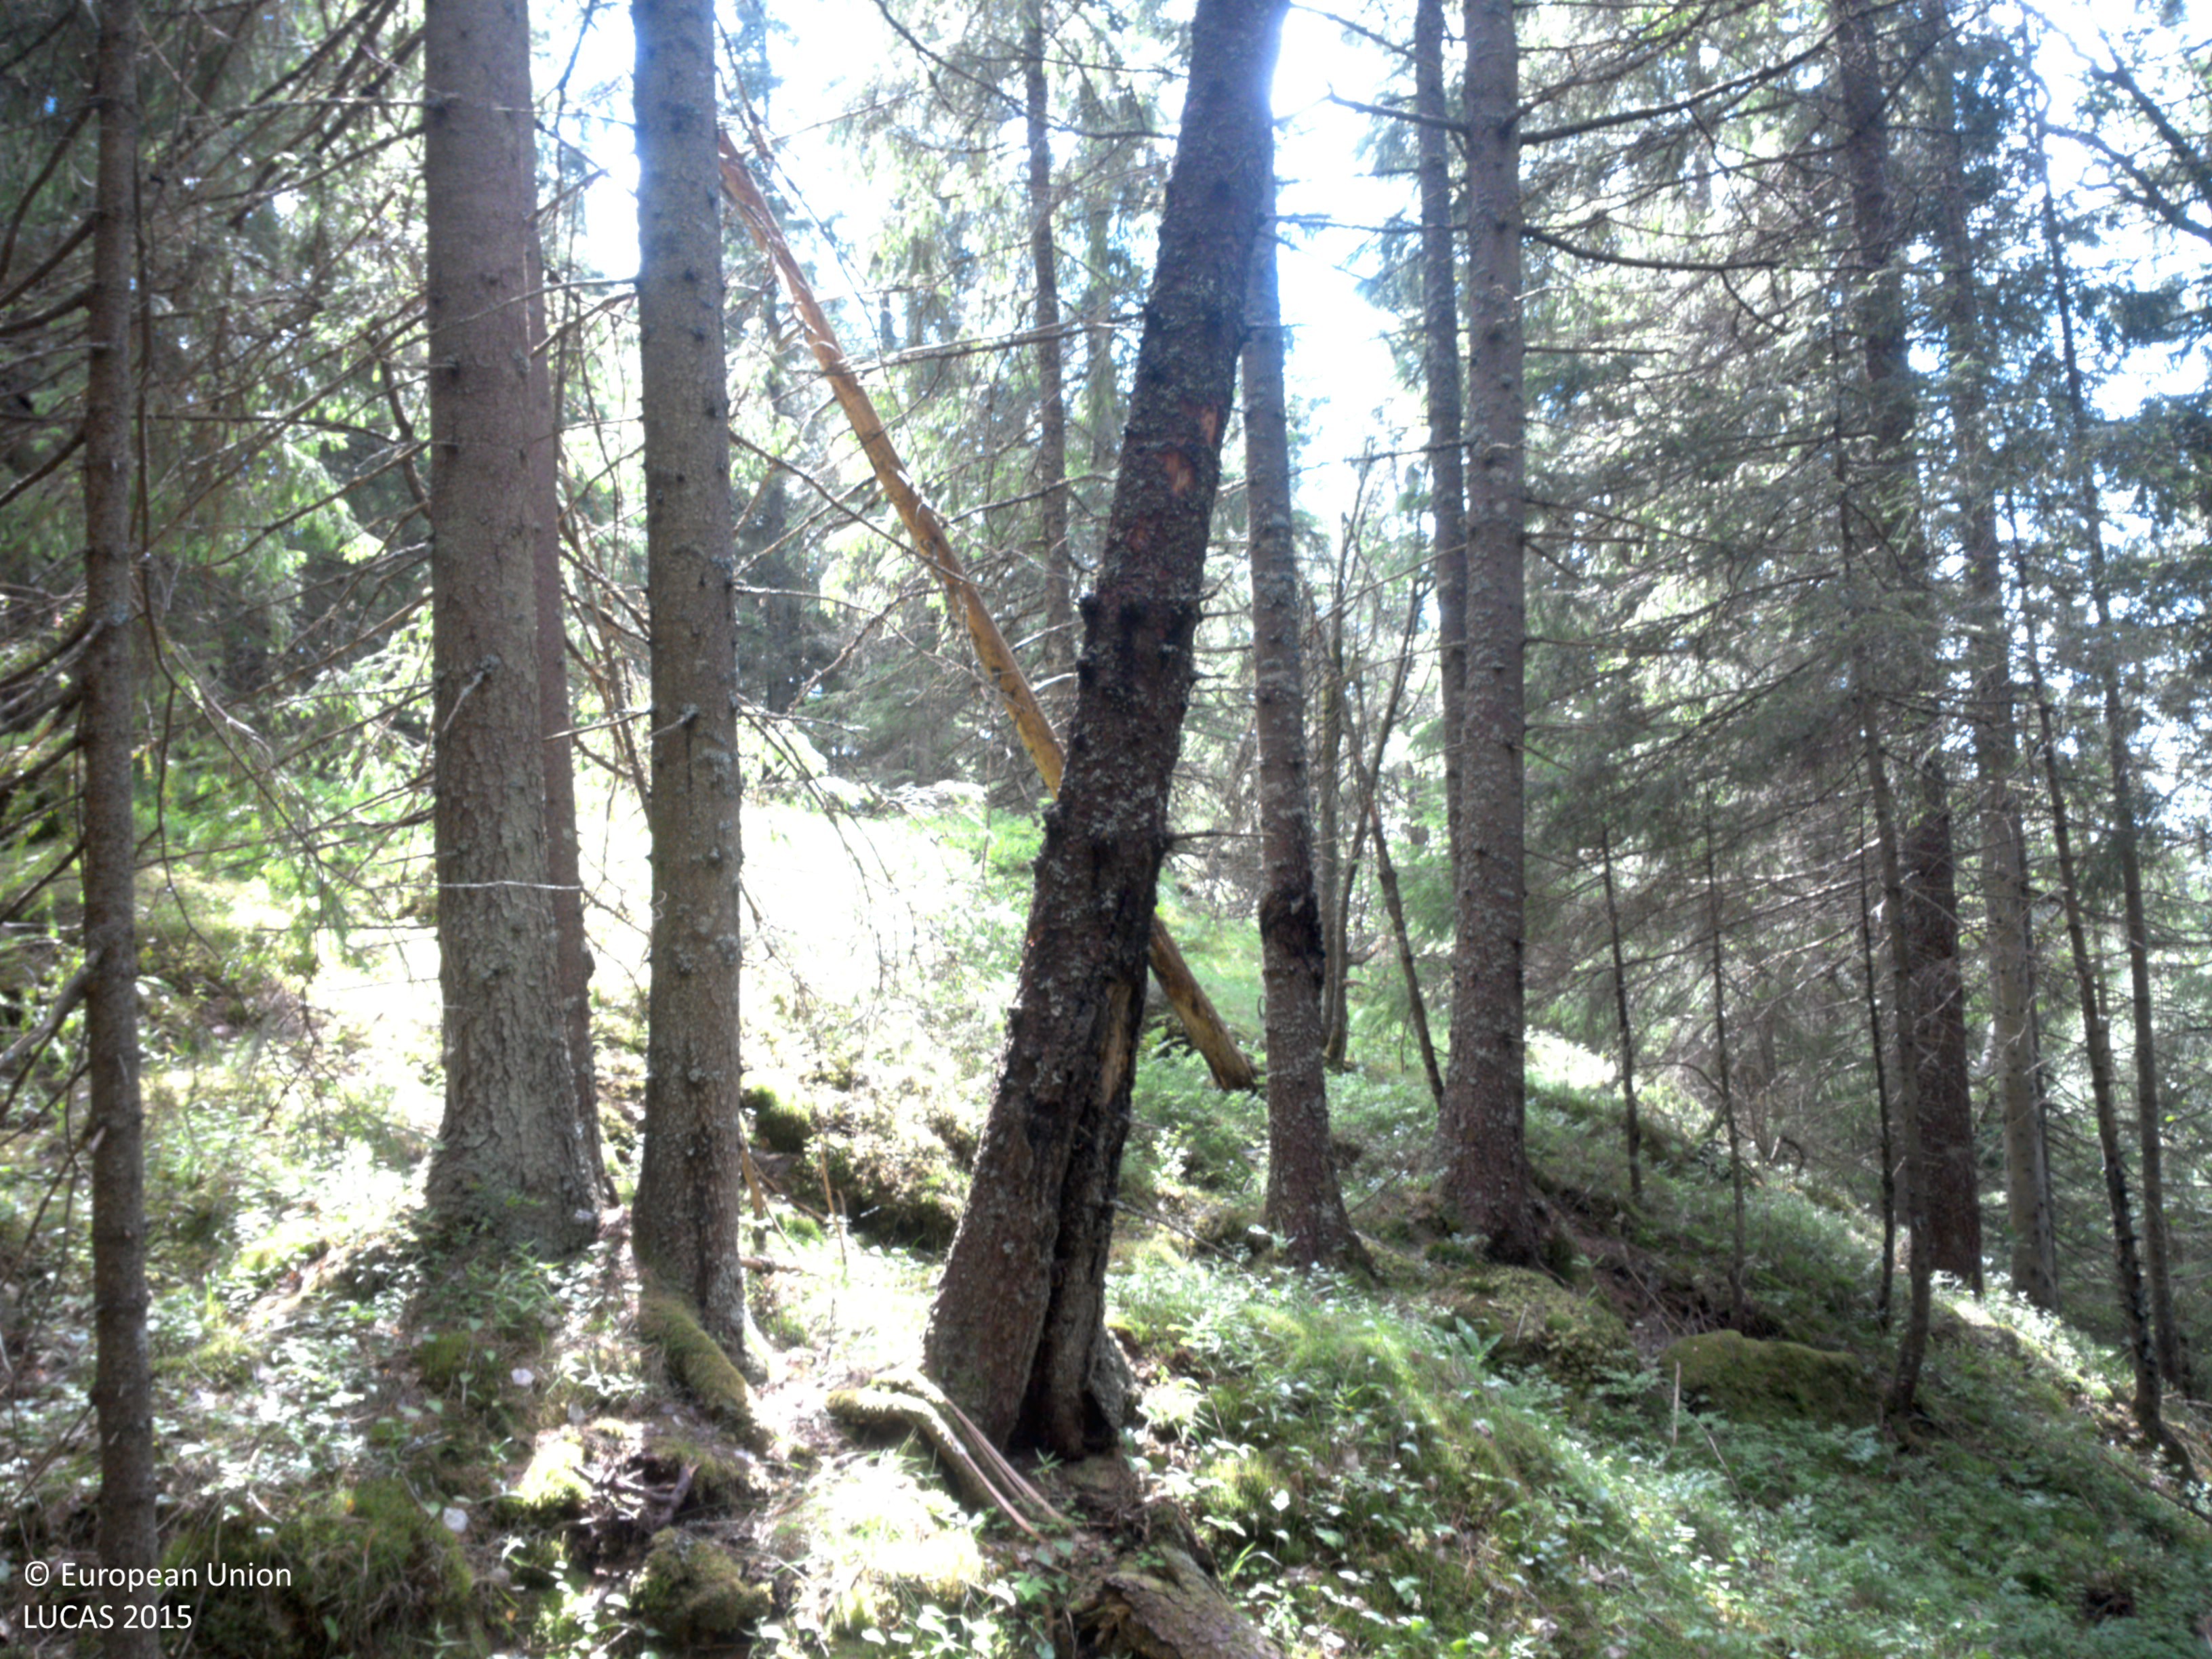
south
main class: Woodland
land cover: Spruce dominated coniferous woodland
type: boreal forest
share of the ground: 50 - 75 %
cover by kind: coniferous forest trees 65 %, lichens and mosses 20 %, shrubs 15 %
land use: Forestry
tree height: > 5 m
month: July
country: SE
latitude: 58.7991
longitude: 11.9513
